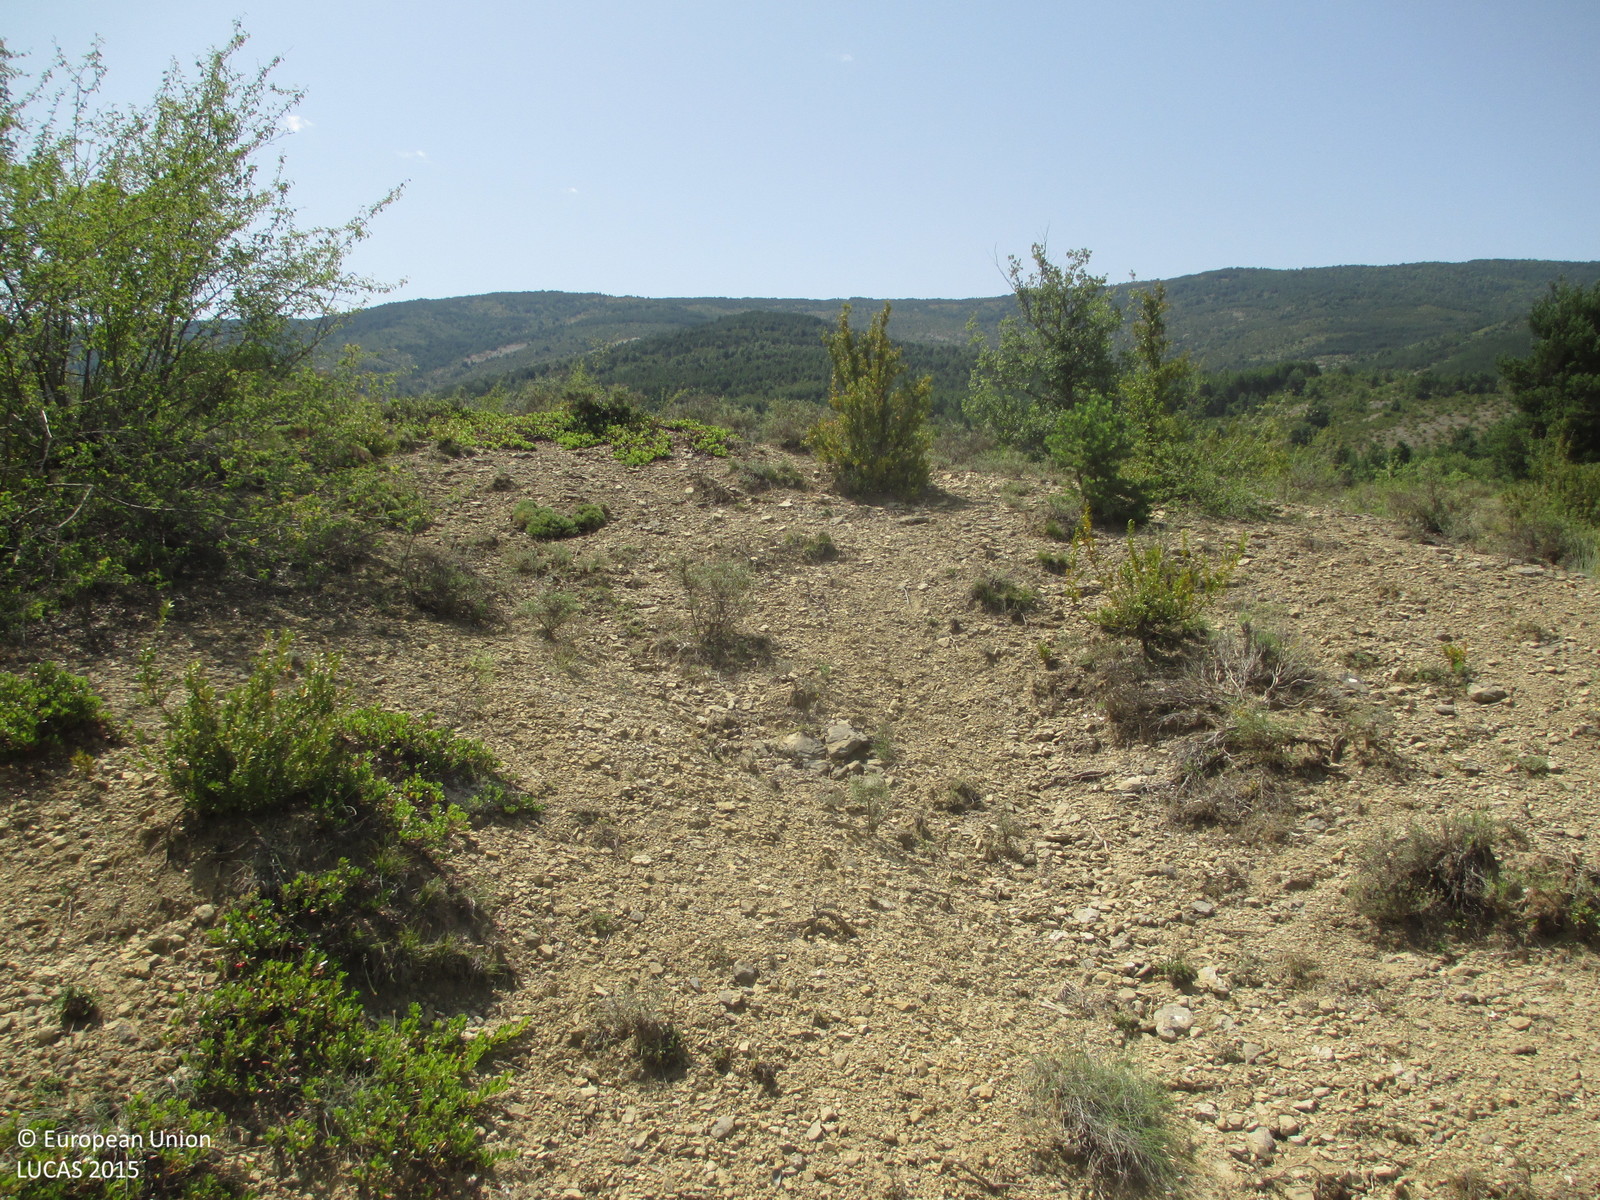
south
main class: Woodland
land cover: Pine dominated coniferous woodland
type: coniferous forest of the mediterranean region
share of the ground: > 75 %
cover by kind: coniferous forest trees 75 %, shrubs 10 %, broadleaved forest trees 5 %, herbaceous plants 5 %, unconsolidated bare surface 5 %
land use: Semi-natural and natural areas not in use
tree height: > 5 m
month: July
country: ES
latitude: 42.3662
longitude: -0.4553
